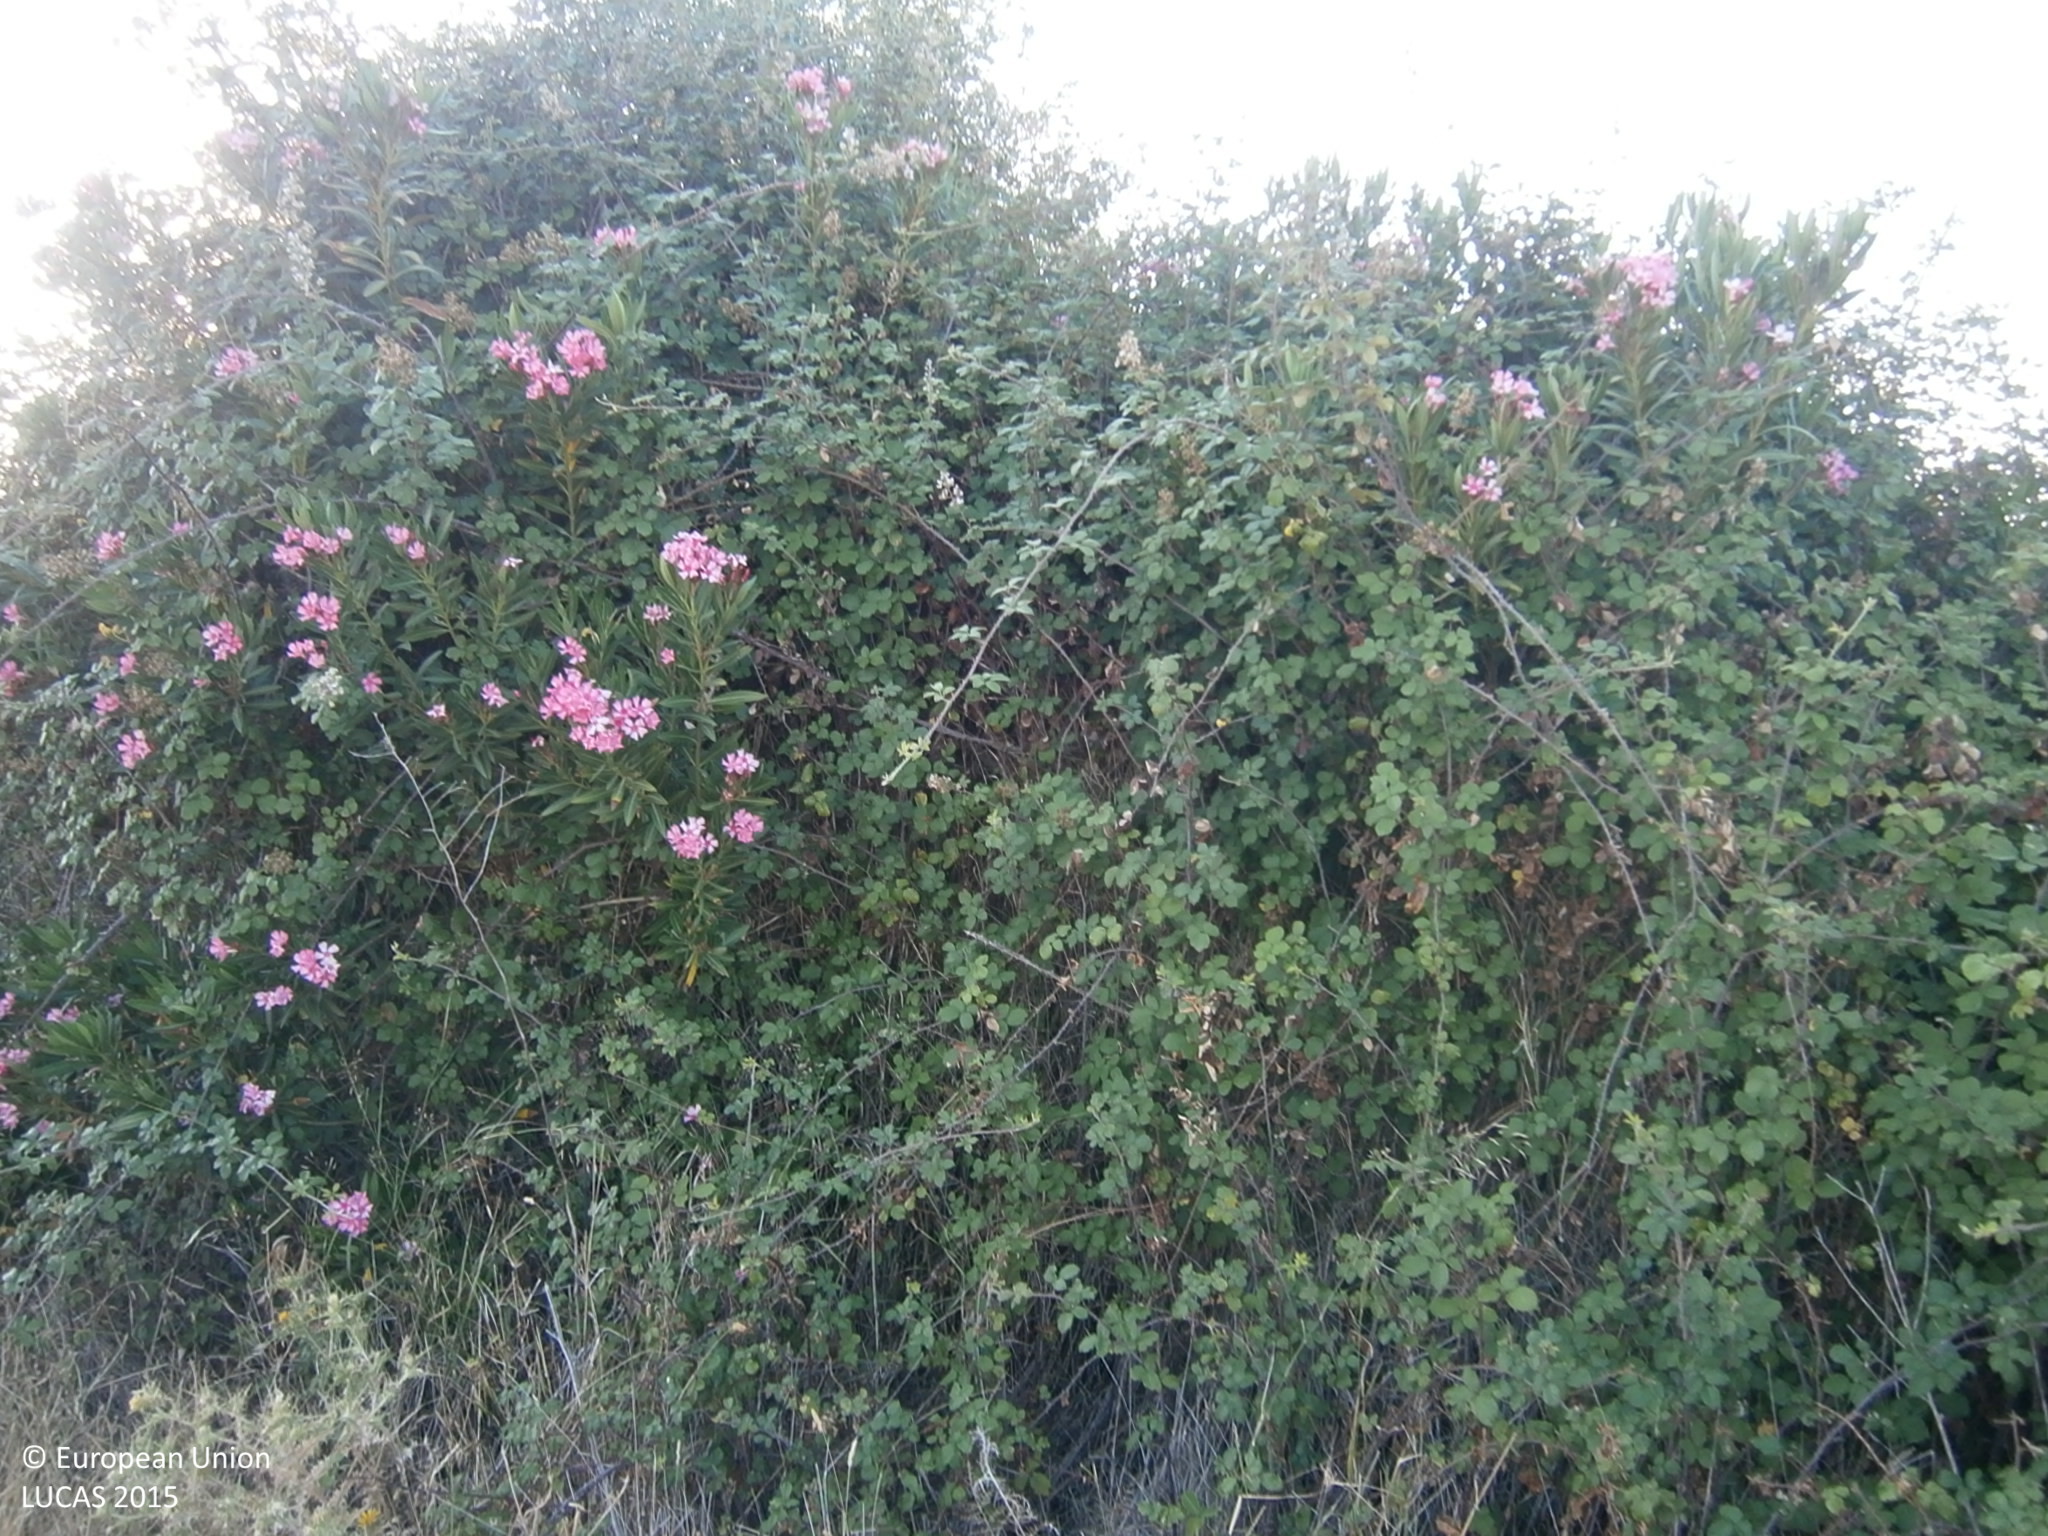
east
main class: Grassland
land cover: Spontaneously vegetated surfaces
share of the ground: > 75 %
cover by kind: herbaceous plants 95 %, unconsolidated bare surface 5 %
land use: Abandoned areas
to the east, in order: Tracks; Shrubland without tree cover; Rivers and streams; Shruby margins; Fences; Olive groves
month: June
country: ES
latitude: 38.6447
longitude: -6.7786
